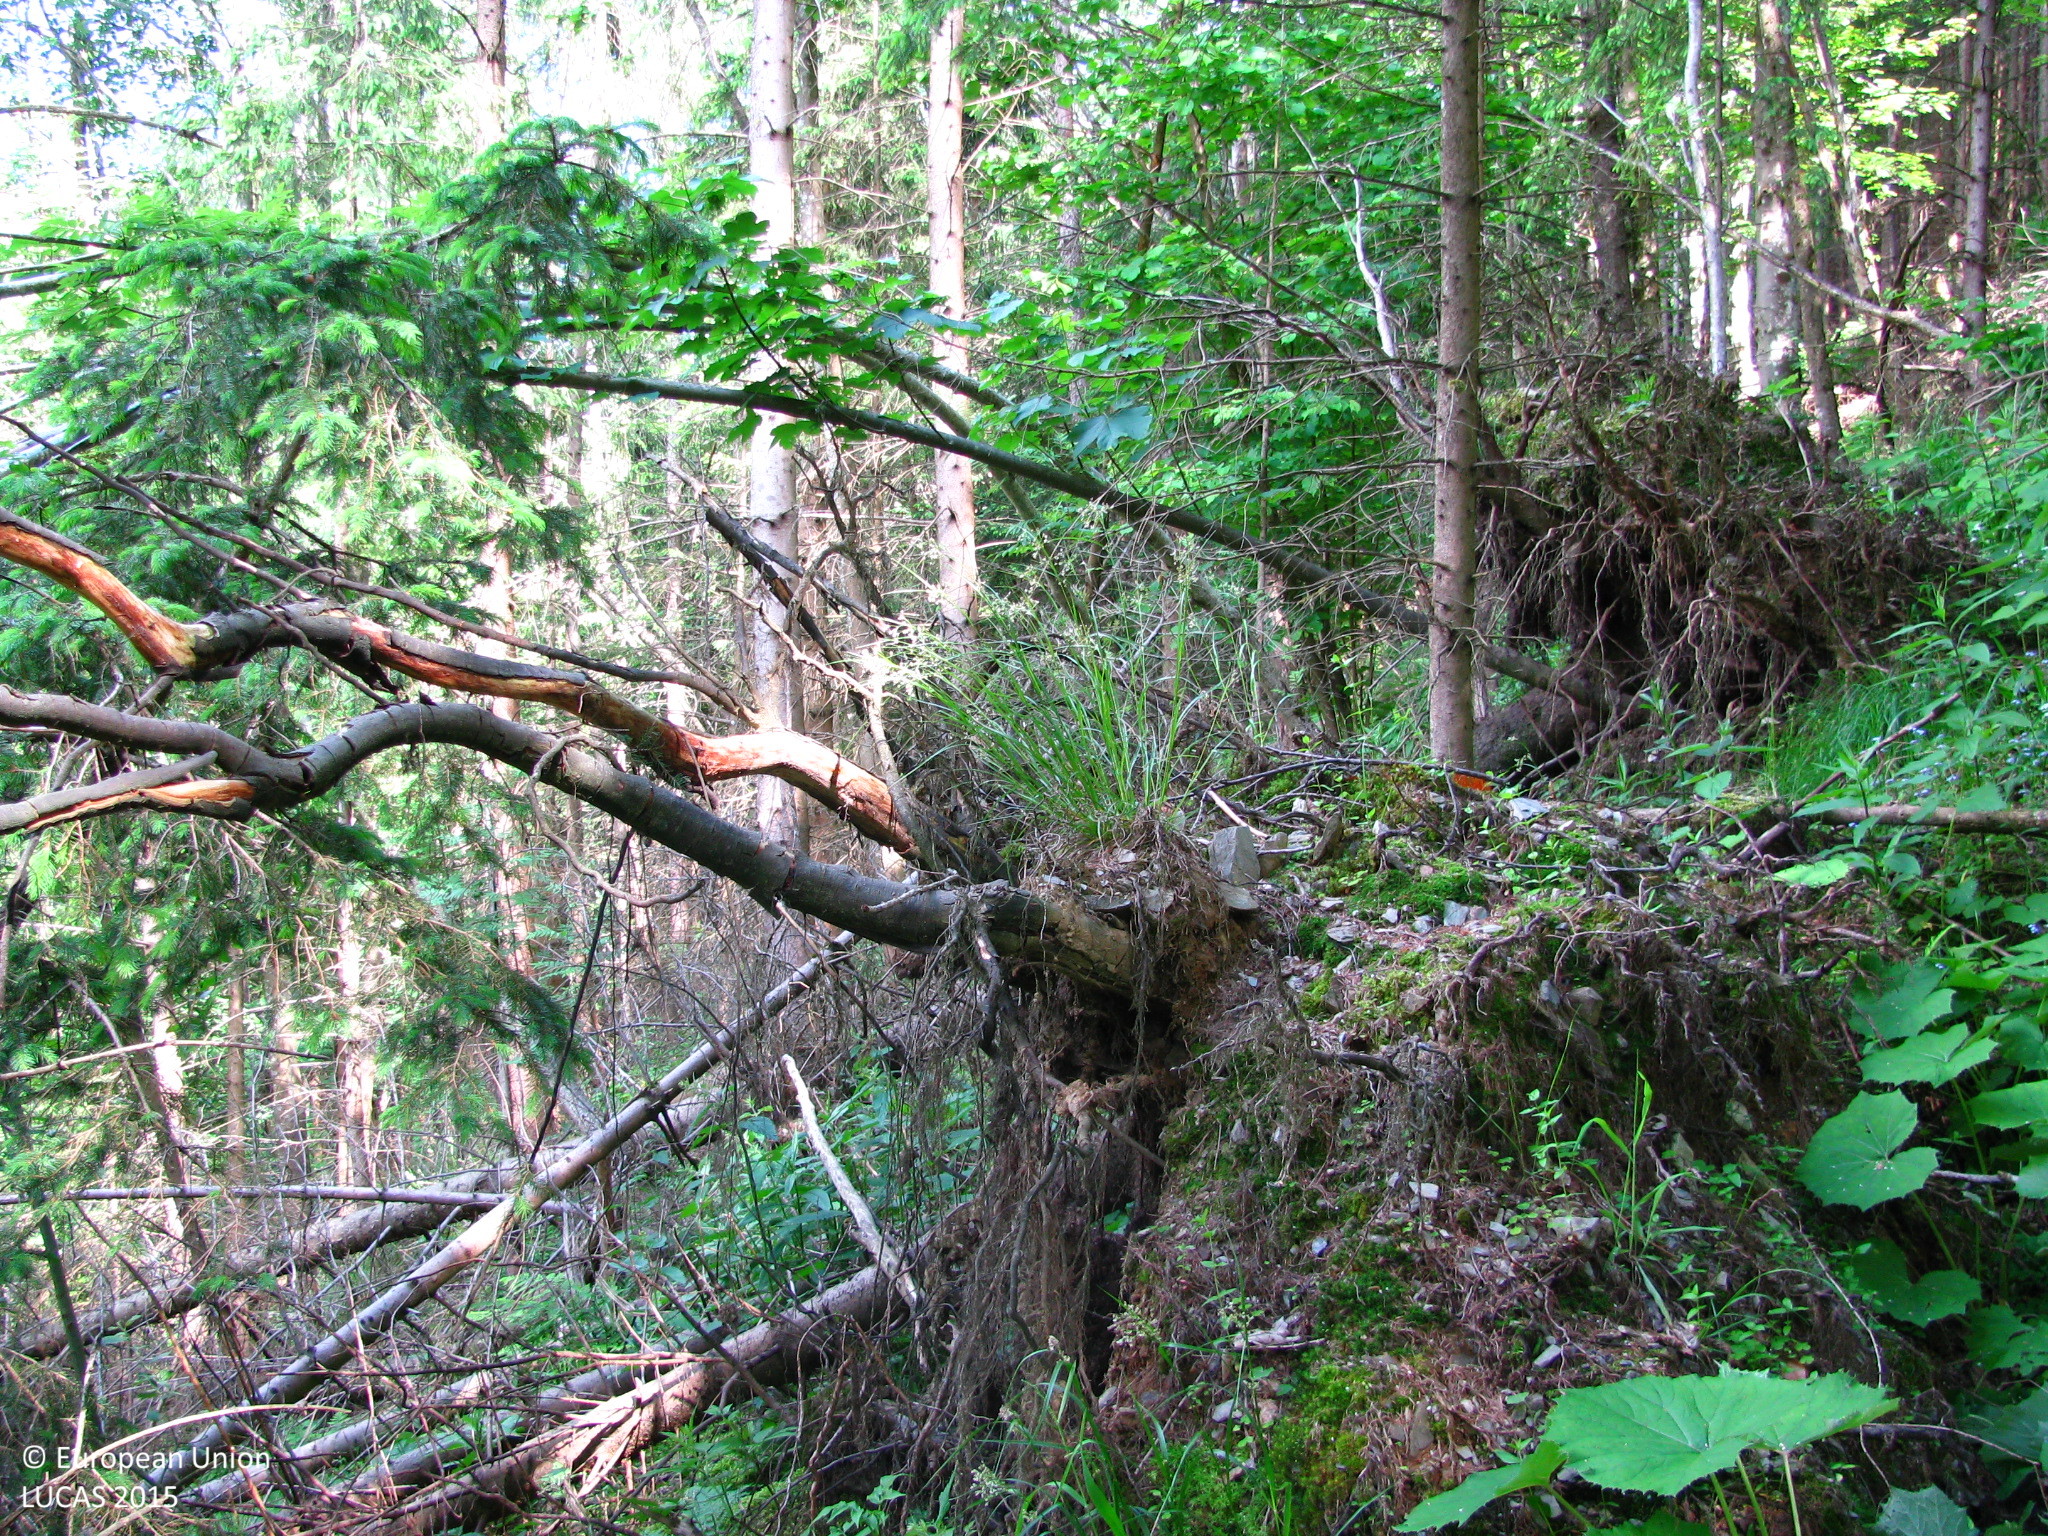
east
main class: Woodland
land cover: Spruce dominated mixed woodland
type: alpine coniferous forest
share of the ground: > 75 %
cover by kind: broadleaved forest trees 50 %, coniferous forest trees 30 %, herbaceous plants 15 %, lichens and mosses 5 %
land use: Forestry
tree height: > 5 m
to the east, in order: Spruce dominated mixed woodland; Spruce dominated coniferous woodland; Spruce dominated mixed woodland; Spruce dominated coniferous woodland; Tracks; Spruce dominated coniferous woodland; Tracks; Grassland without tree/shrub cover
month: June
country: AT
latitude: 47.4454
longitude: 14.9463
